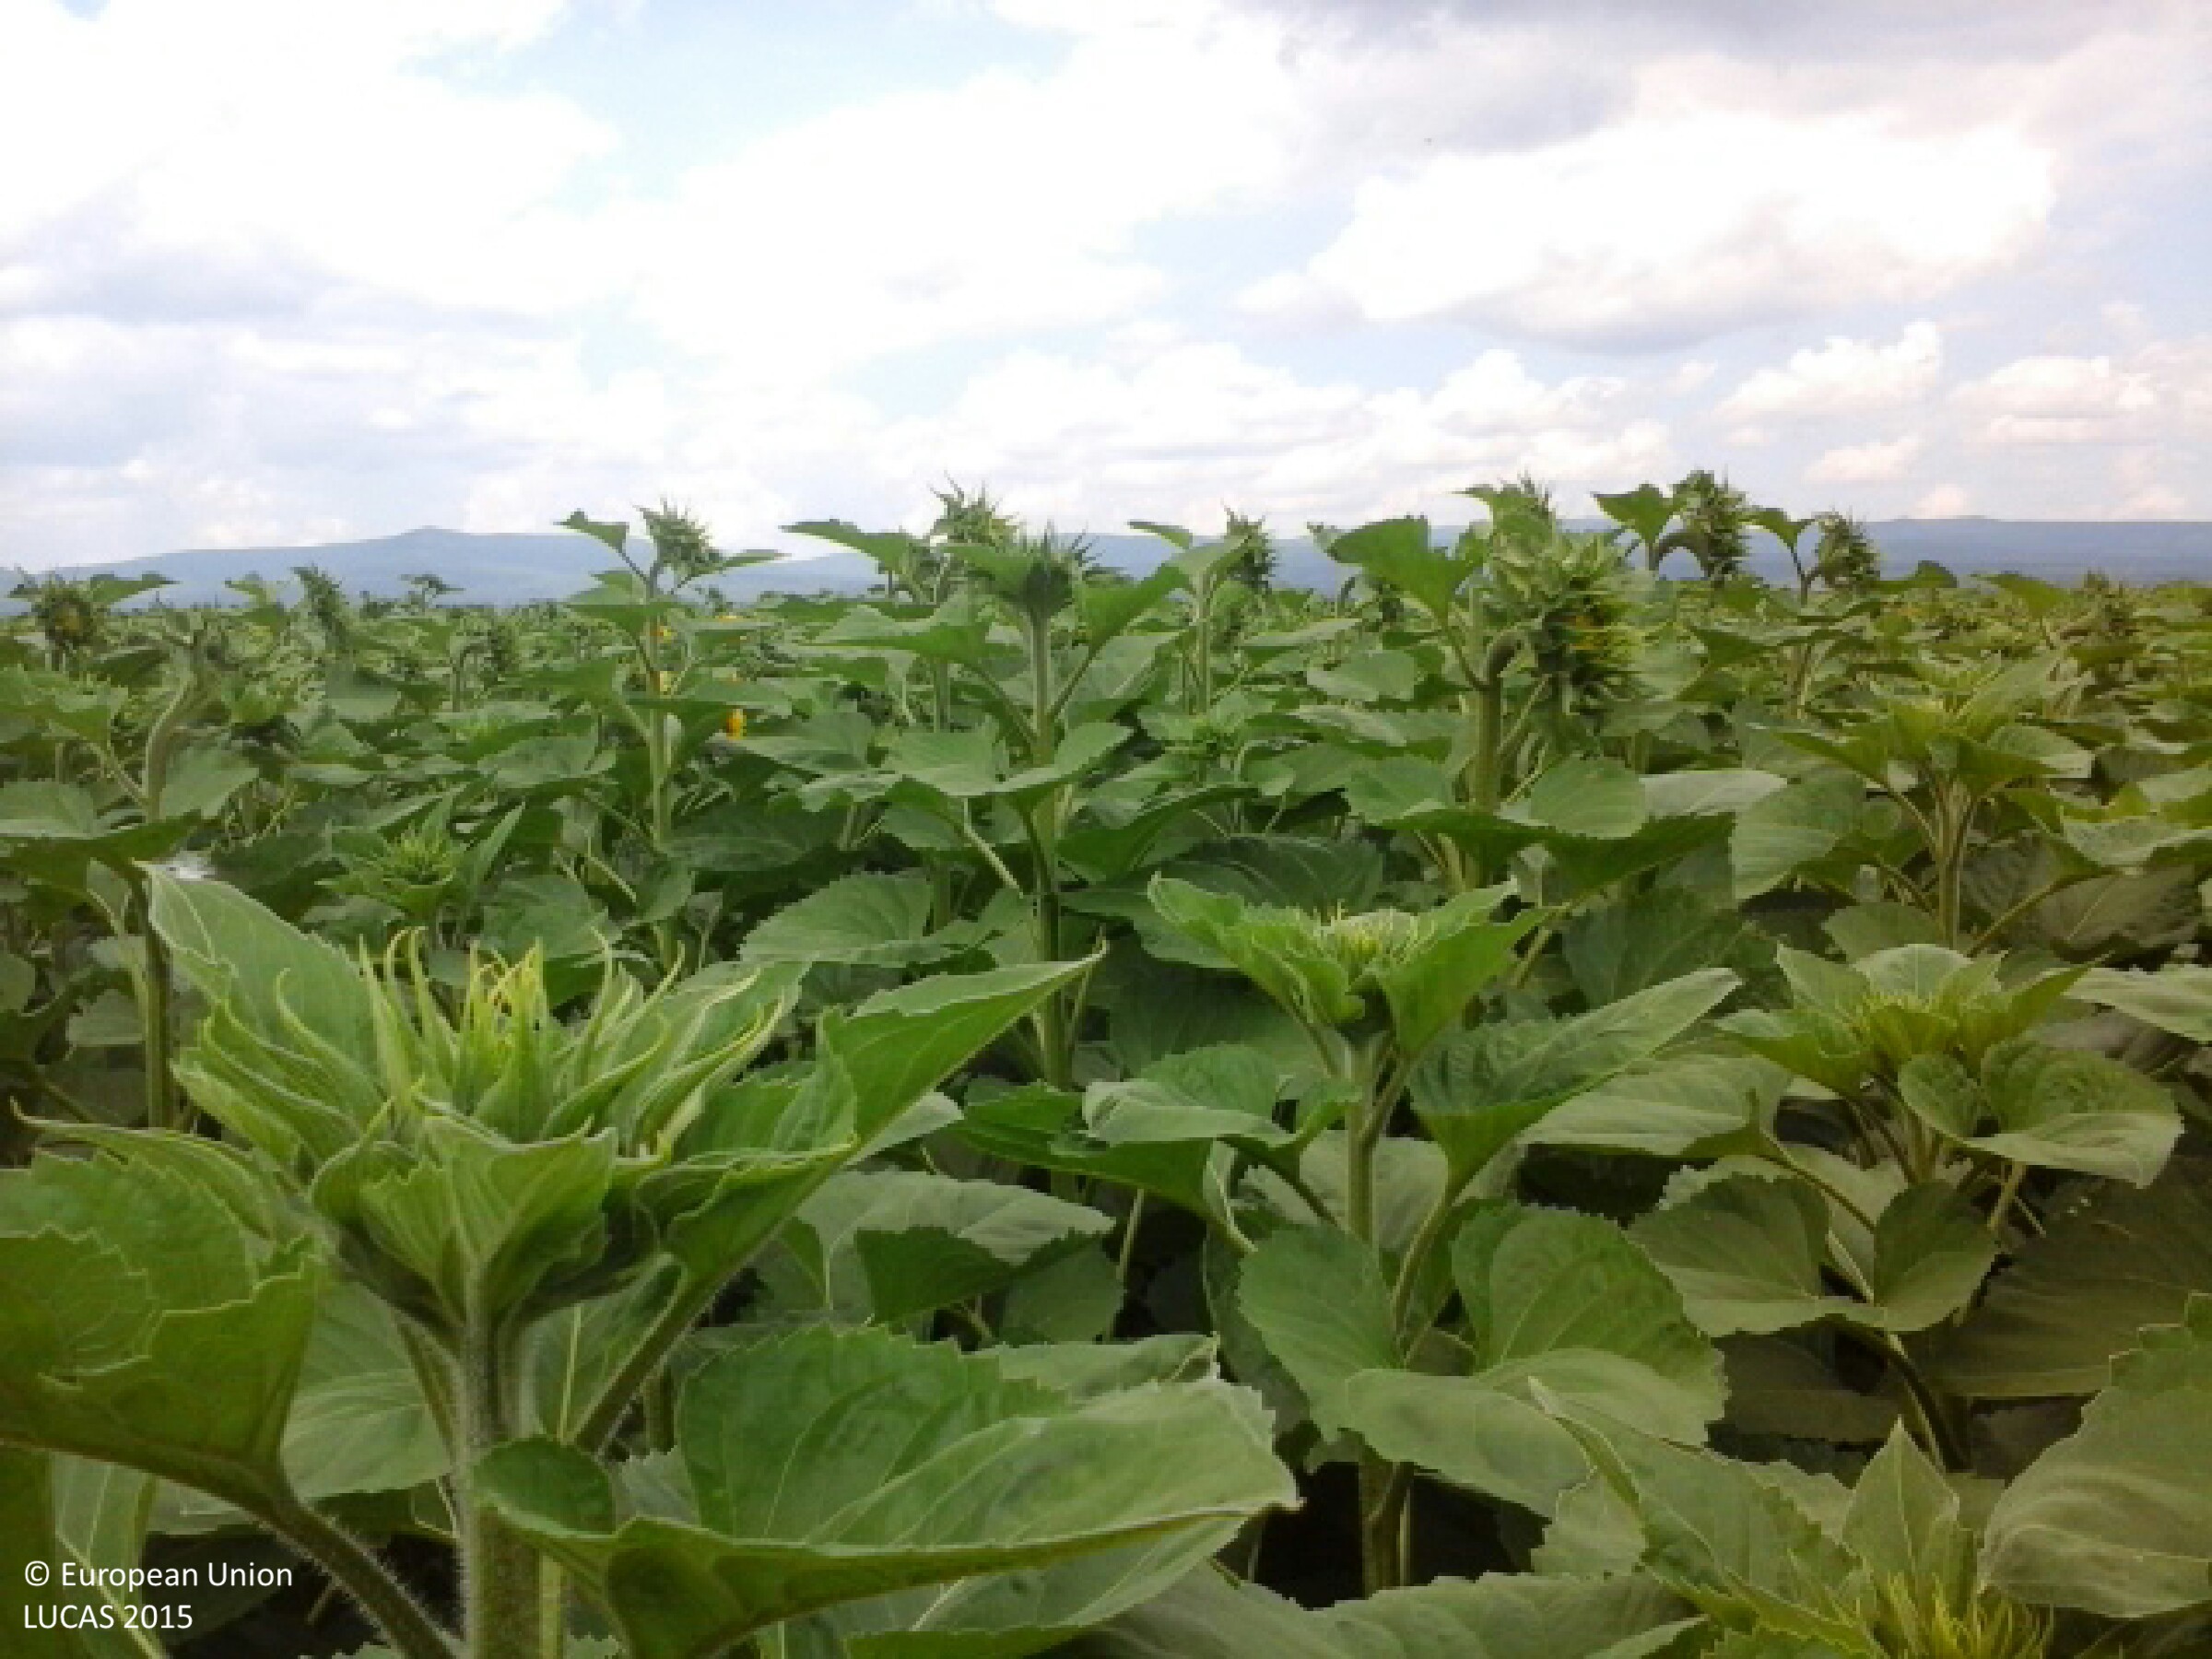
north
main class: Cropland
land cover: Sunflower
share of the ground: > 75 %
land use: Agriculture (excluding fallow land and kitchen gardens)
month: June
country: HU
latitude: 47.7779
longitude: 19.8884
